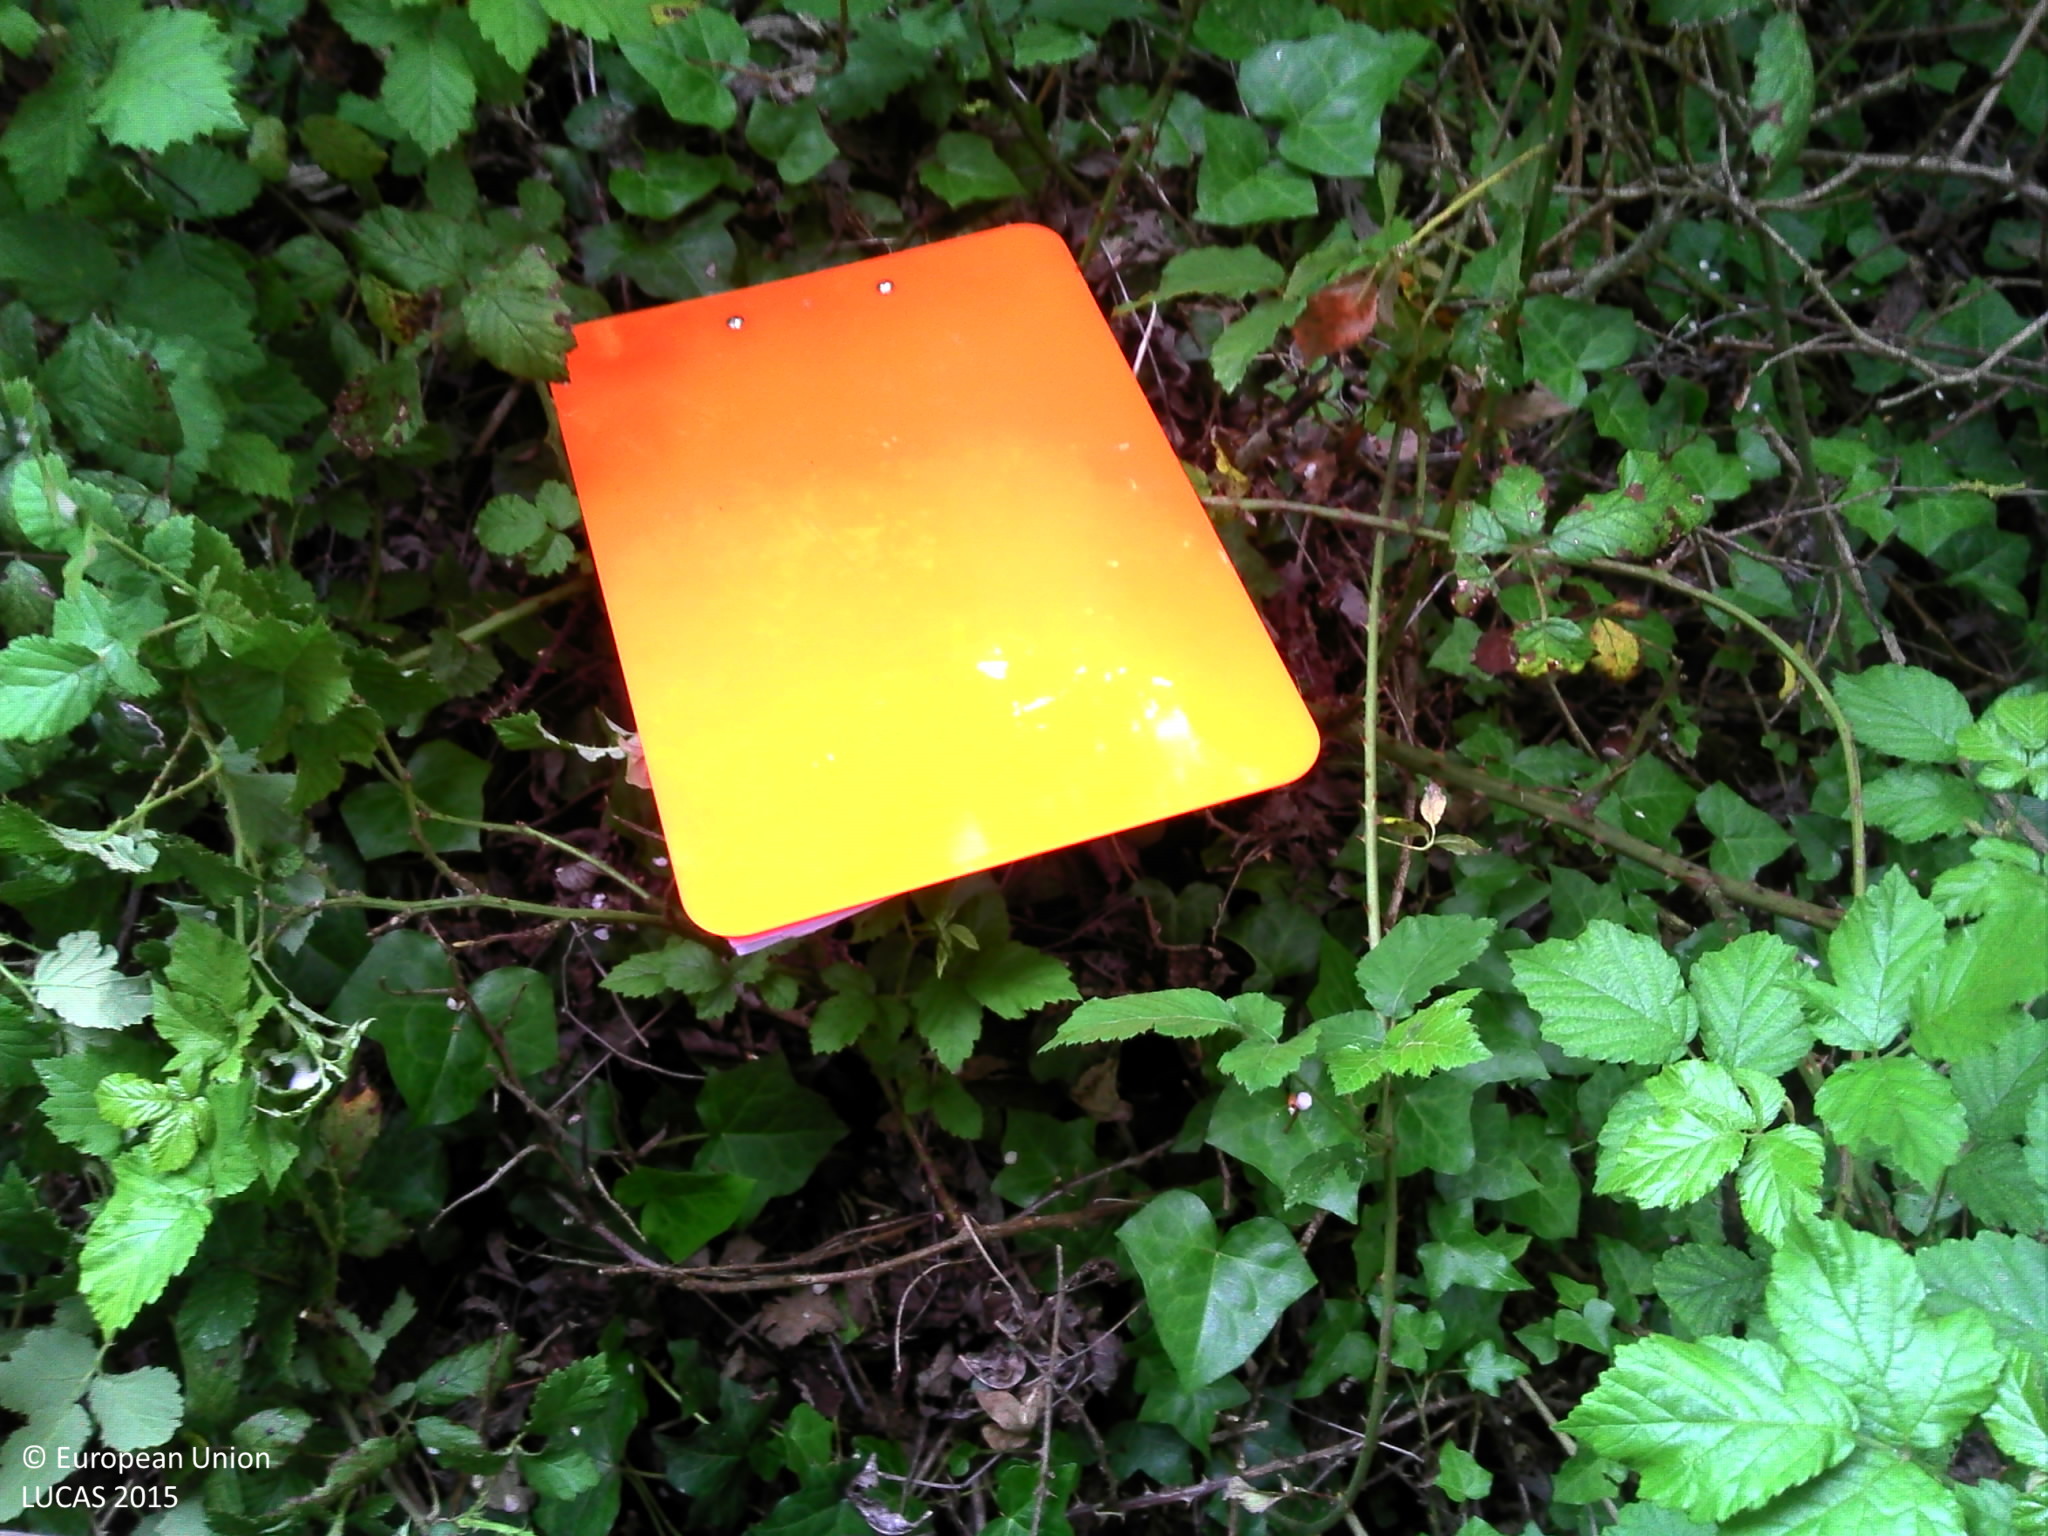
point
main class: Woodland
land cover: Broadleaved woodland
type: mesophytic deciduous forest
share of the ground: > 75 %
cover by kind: broadleaved forest trees 75 %, shrubs 20 %, herbaceous plants 5 %
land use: Semi-natural and natural areas not in use
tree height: > 5 m
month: May
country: FR
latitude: 49.3116
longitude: -0.3652
